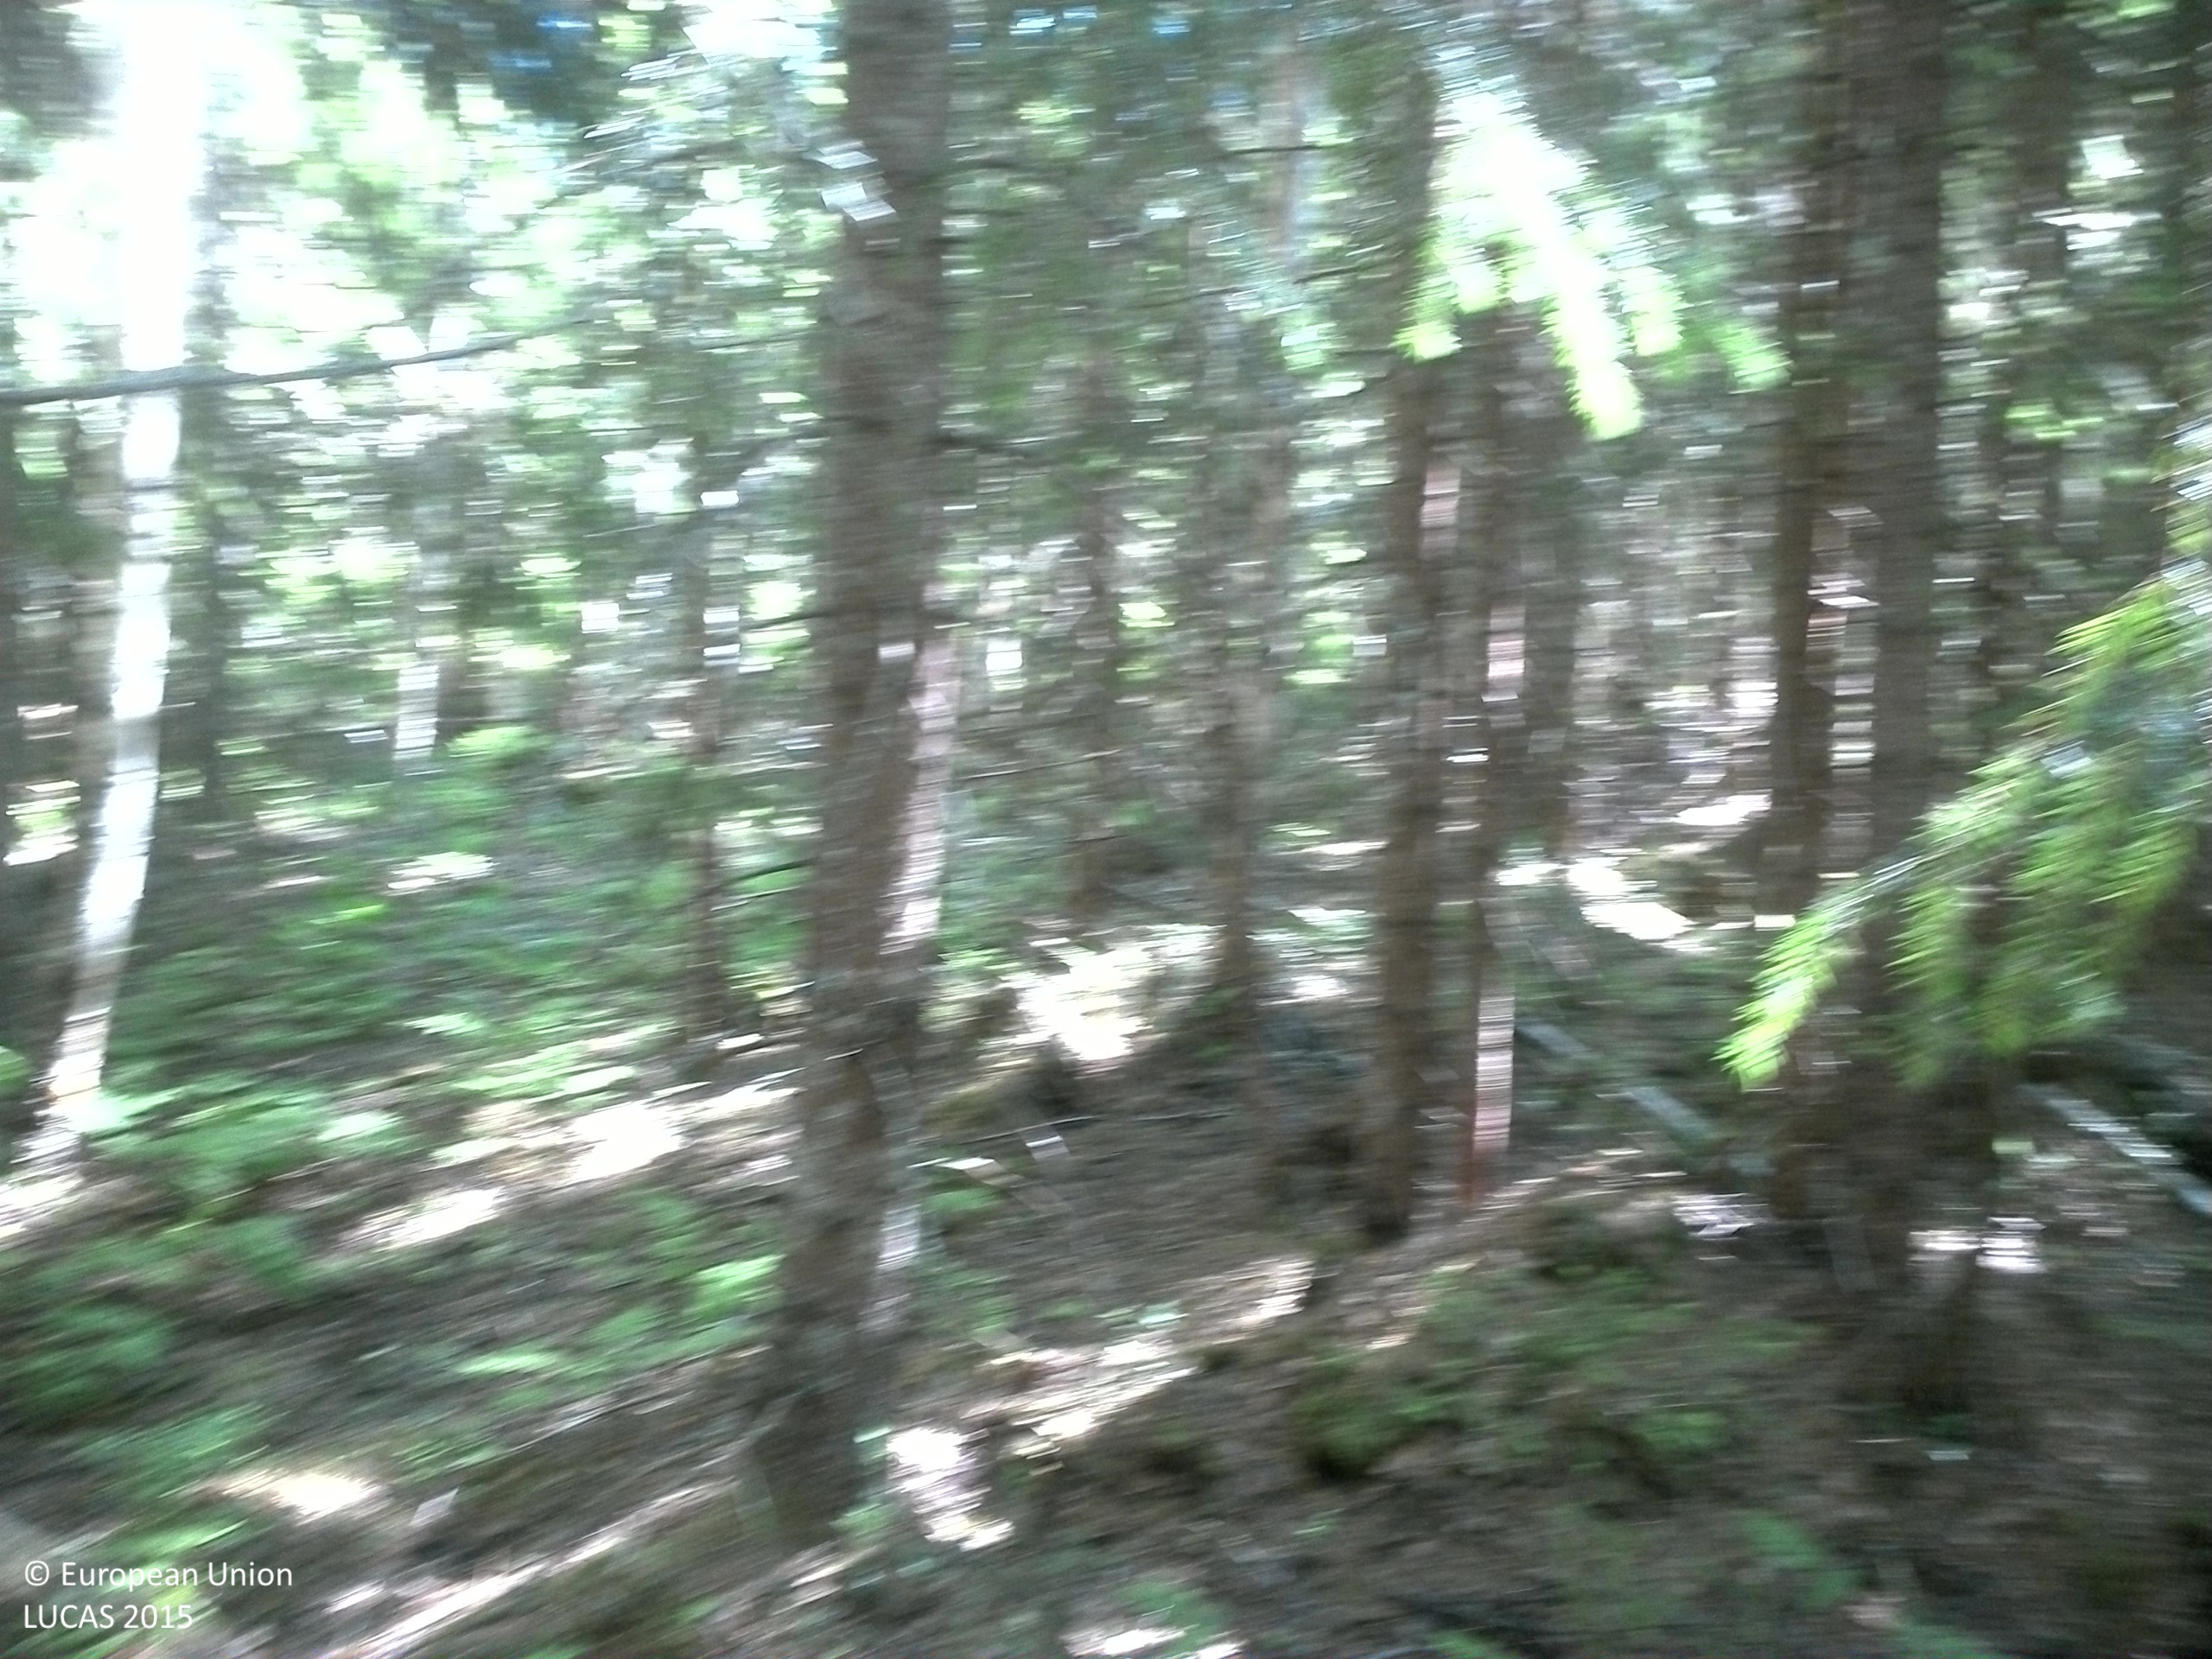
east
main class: Woodland
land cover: Spruce dominated mixed woodland
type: boreal forest
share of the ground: > 75 %
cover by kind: coniferous forest trees 65 %, broadleaved forest trees 25 %, herbaceous plants 10 %
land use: Forestry
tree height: > 5 m
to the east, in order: Spruce dominated mixed woodland; Pine dominated mixed woodland; Spruce dominated mixed woodland
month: July
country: SE
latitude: 62.7808
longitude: 17.6411
